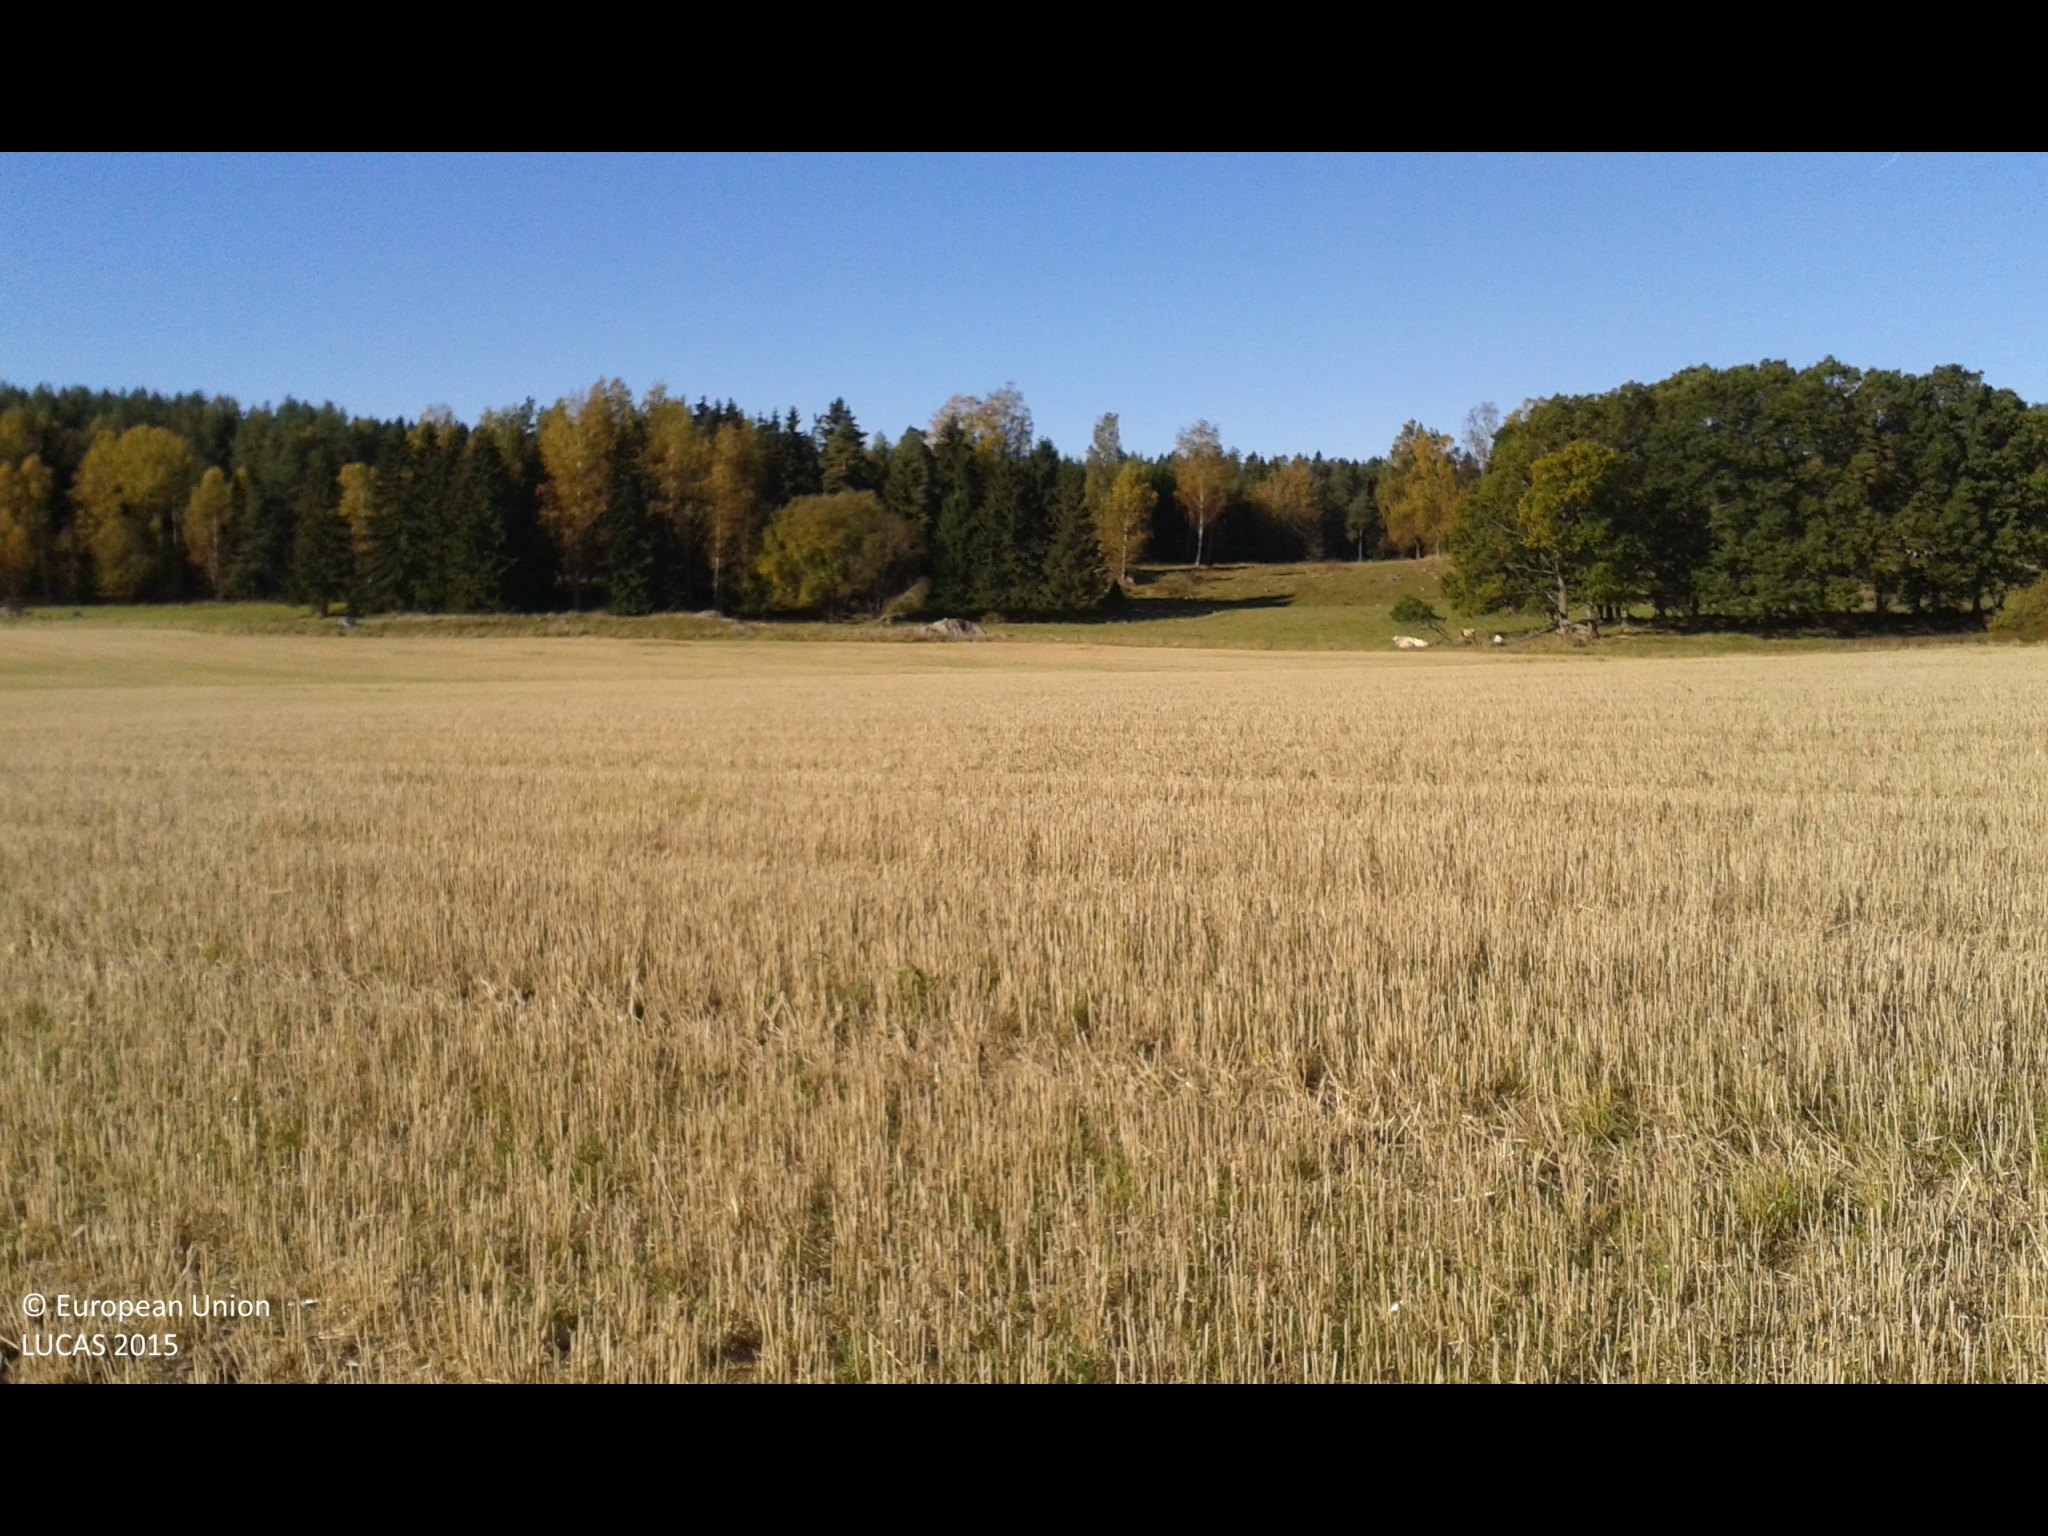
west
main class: Cropland
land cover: Barley
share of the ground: < 10 %
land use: Agriculture (excluding fallow land and kitchen gardens)
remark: Harvested field
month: October
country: SE
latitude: 58.8545
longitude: 17.2603
